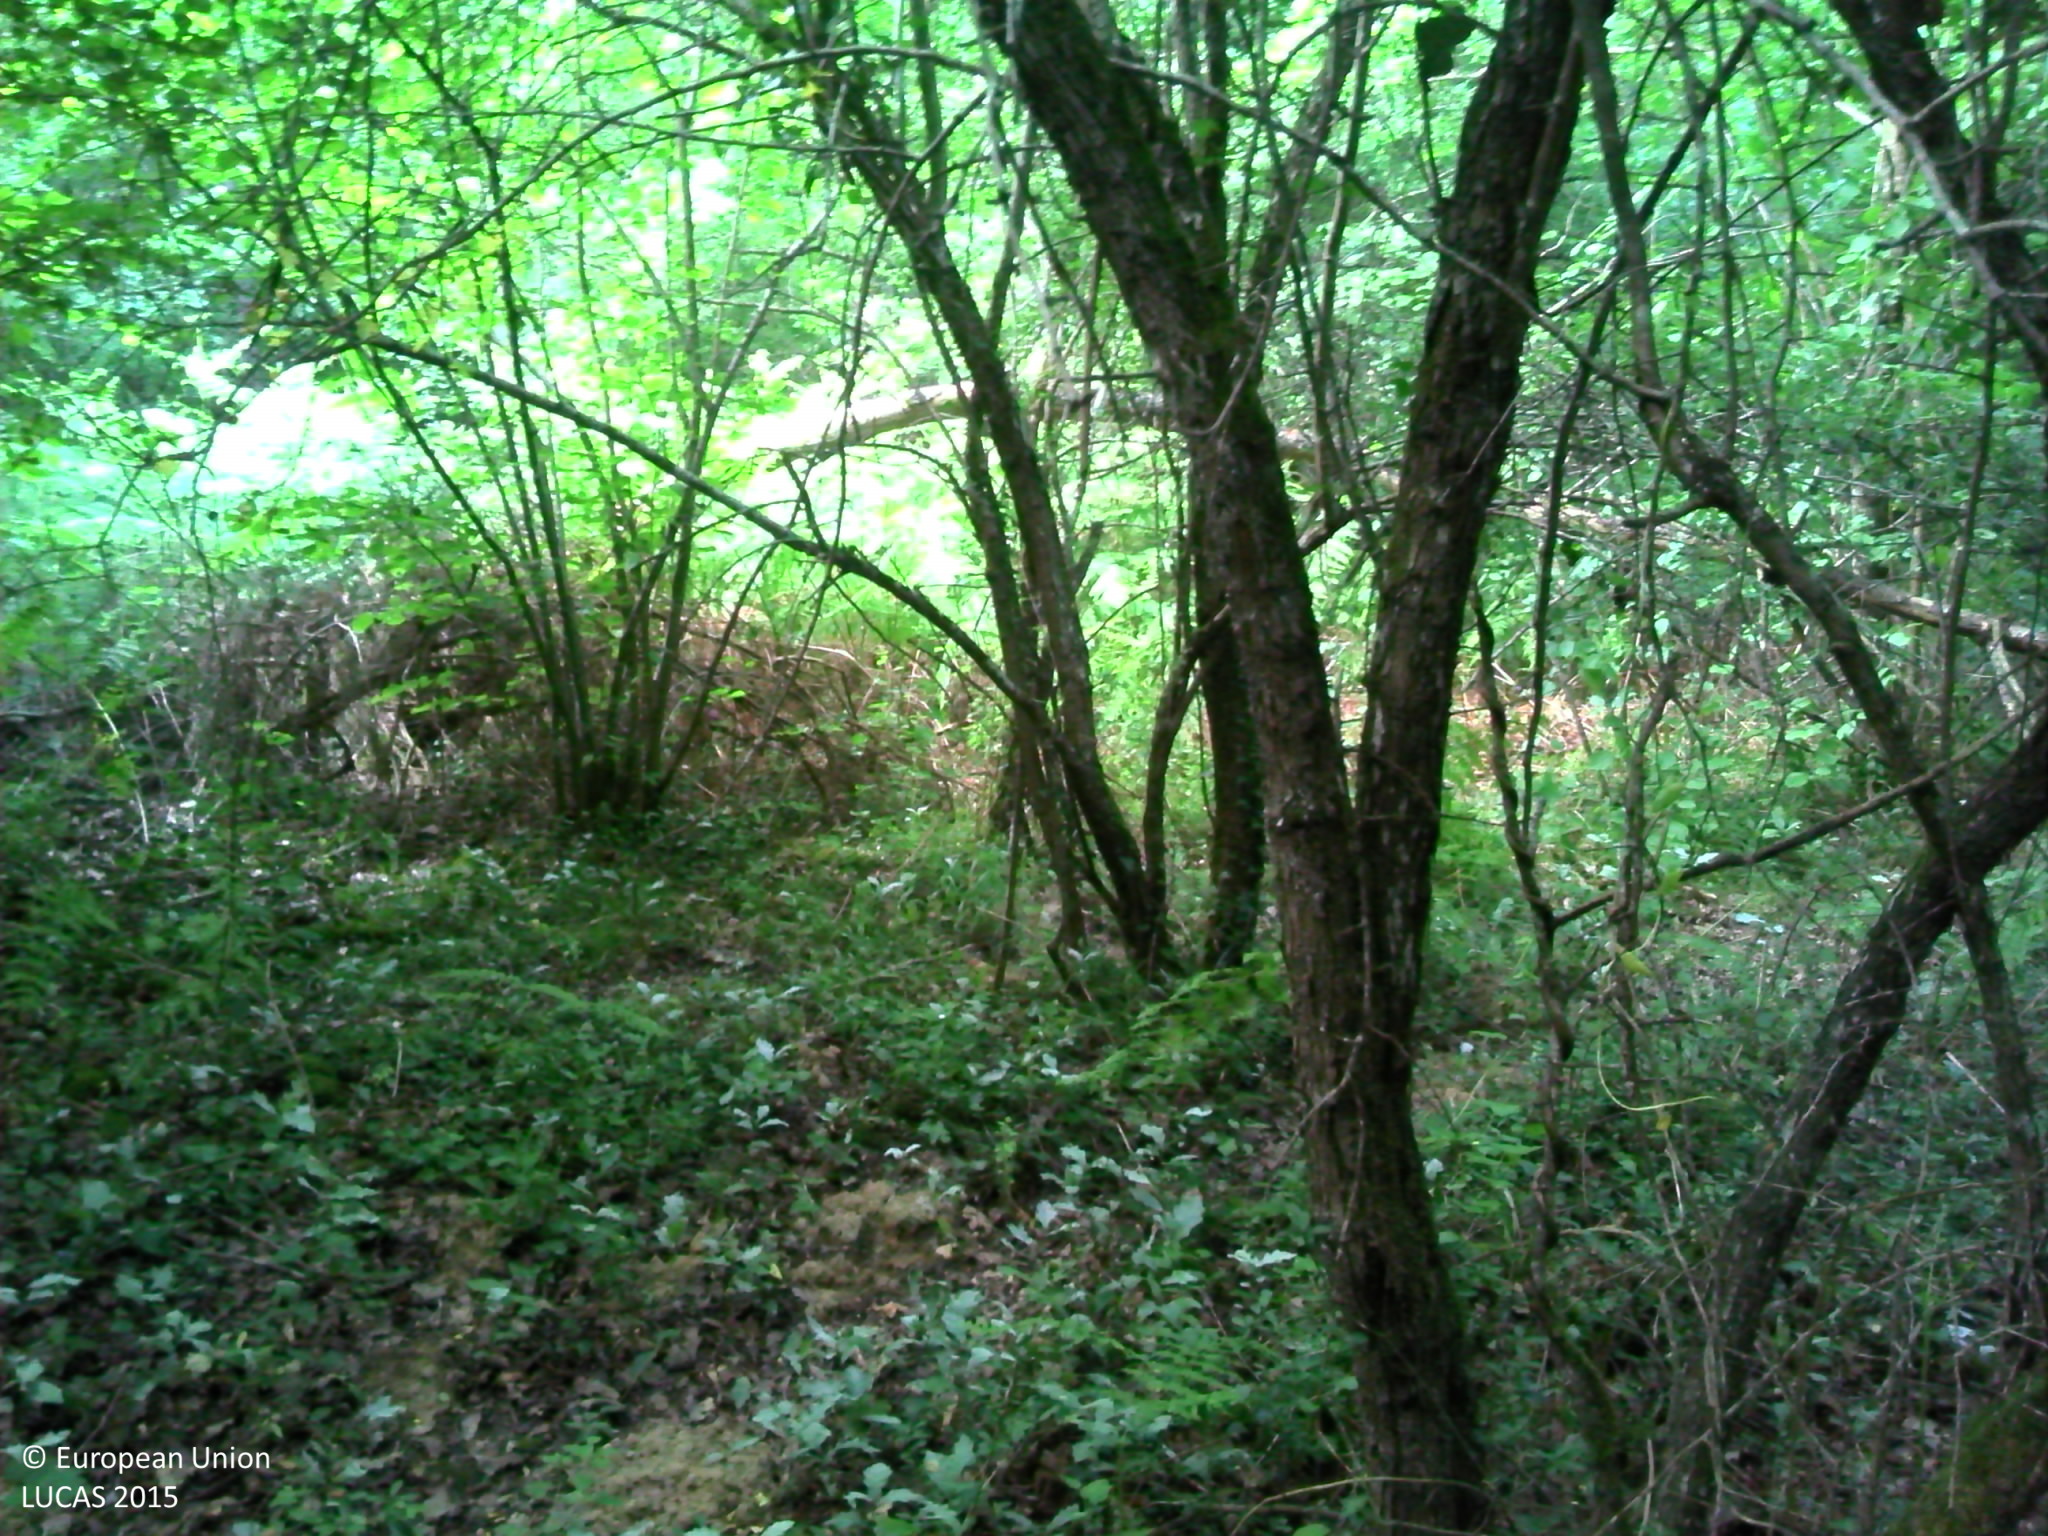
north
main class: Woodland
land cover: Broadleaved woodland
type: acidophilous oak and oak-birch forest
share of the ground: > 75 %
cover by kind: broadleaved forest trees 90 %, shrubs 5 %, herbaceous plants 5 %
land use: Forestry
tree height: > 5 m
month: June
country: FR
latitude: 46.9082
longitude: 0.1179
